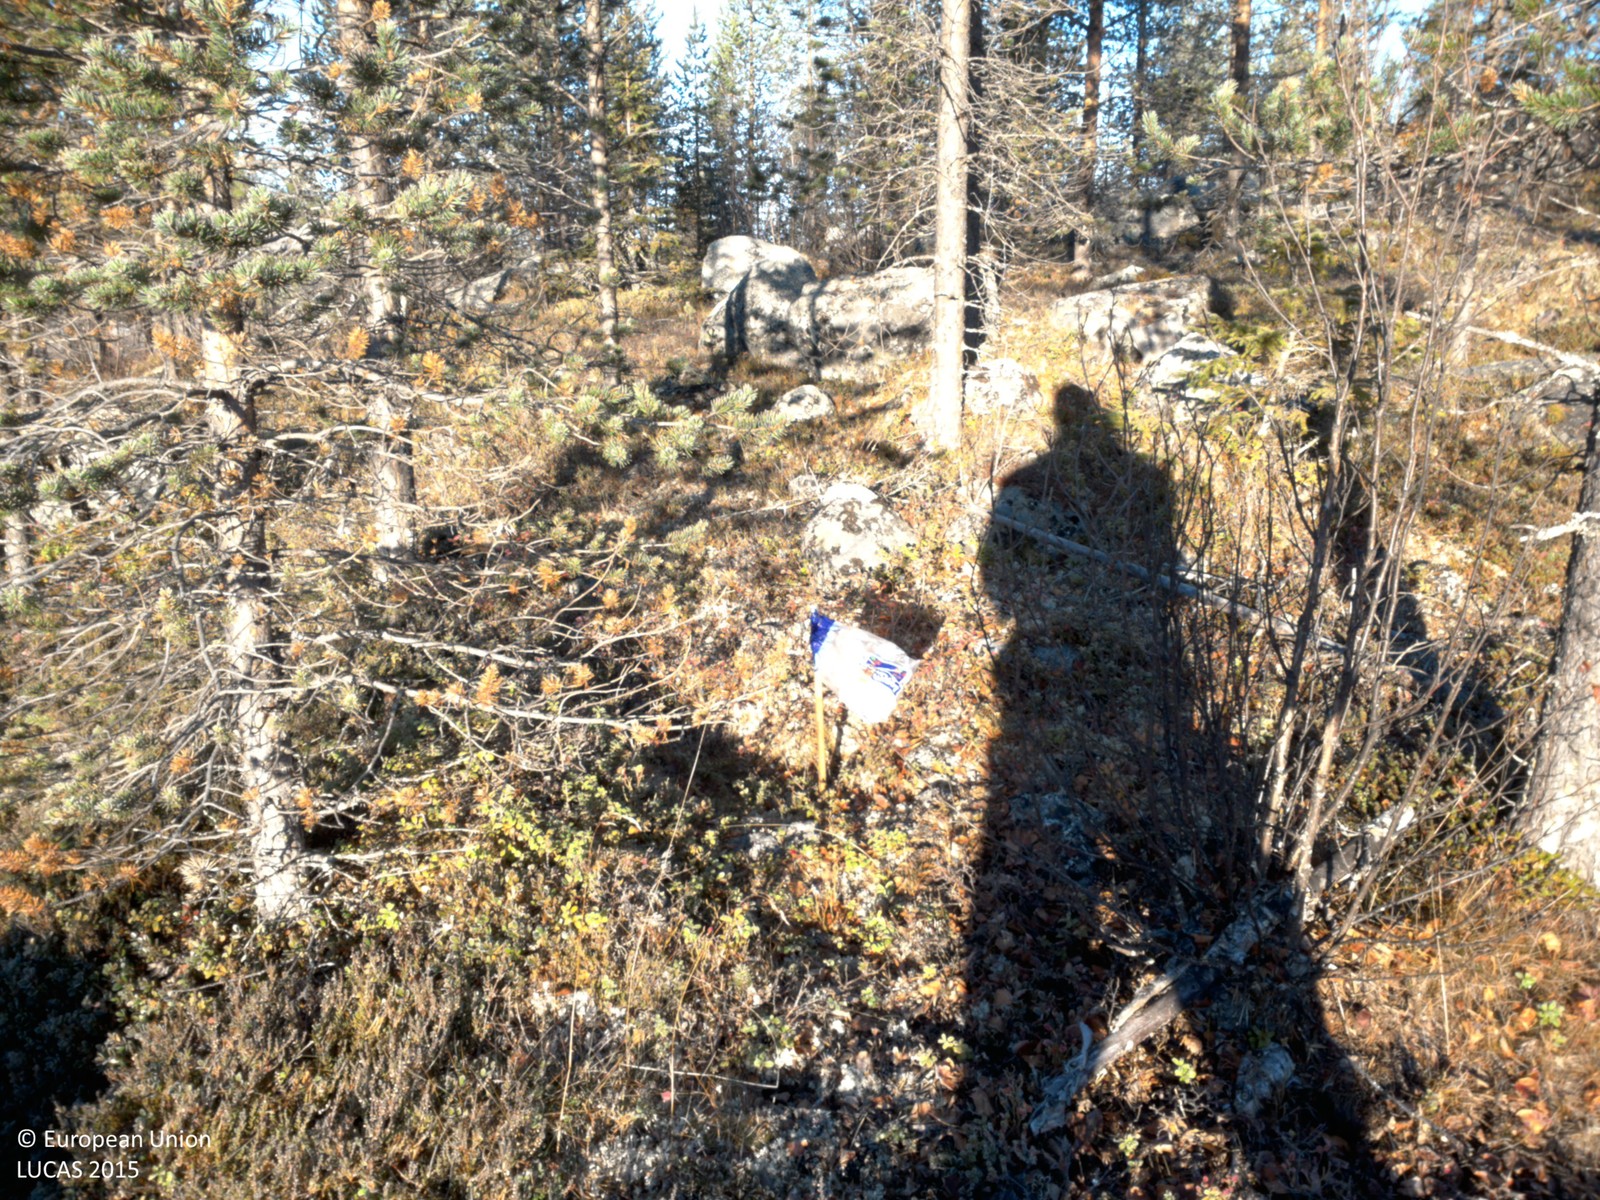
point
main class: Woodland
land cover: Pine dominated coniferous woodland
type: mire and swamp forests
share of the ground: 25 - 50 %
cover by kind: coniferous forest trees 50 %, shrubs 25 %, herbaceous plants 15 %, lichens and mosses 10 %
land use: Forestry
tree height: > 5 m
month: October
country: SE
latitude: 64.7131
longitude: 17.8340
